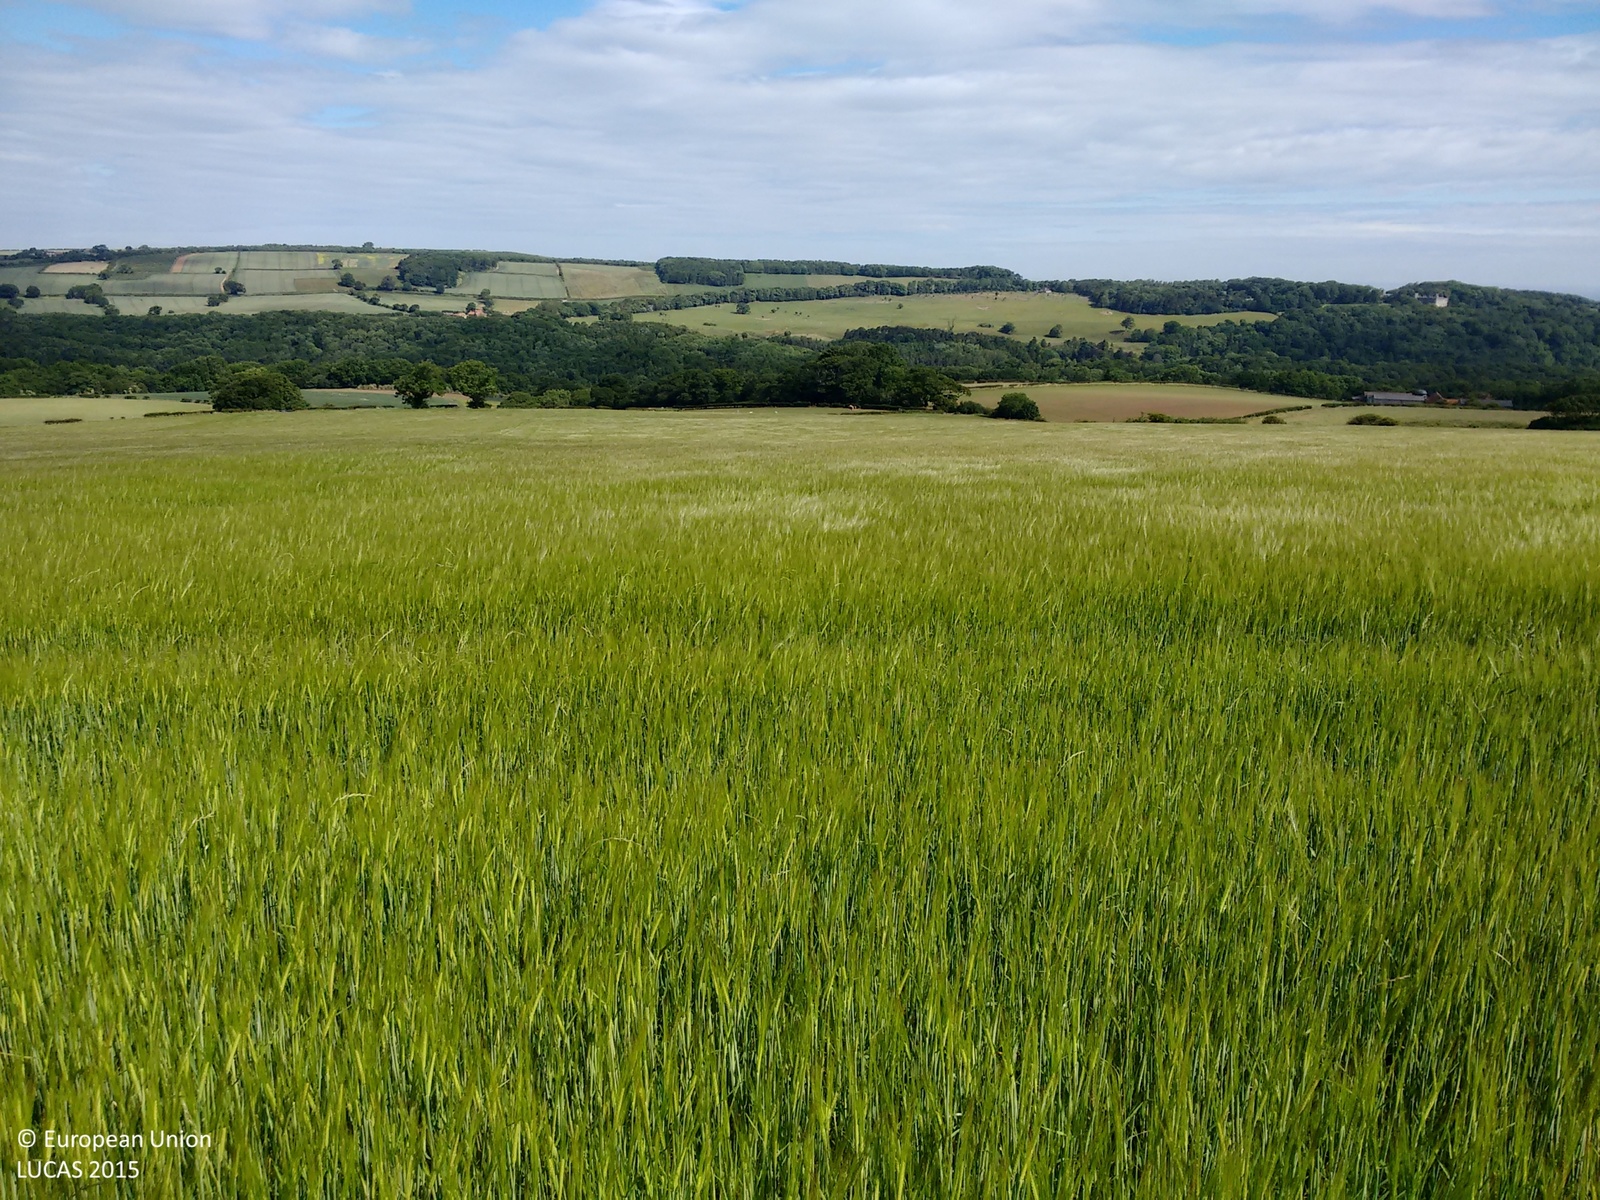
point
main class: Cropland
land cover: Barley
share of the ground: > 75 %
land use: Agriculture (excluding fallow land and kitchen gardens)
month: June
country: GB
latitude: 54.4864
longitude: -0.7046
